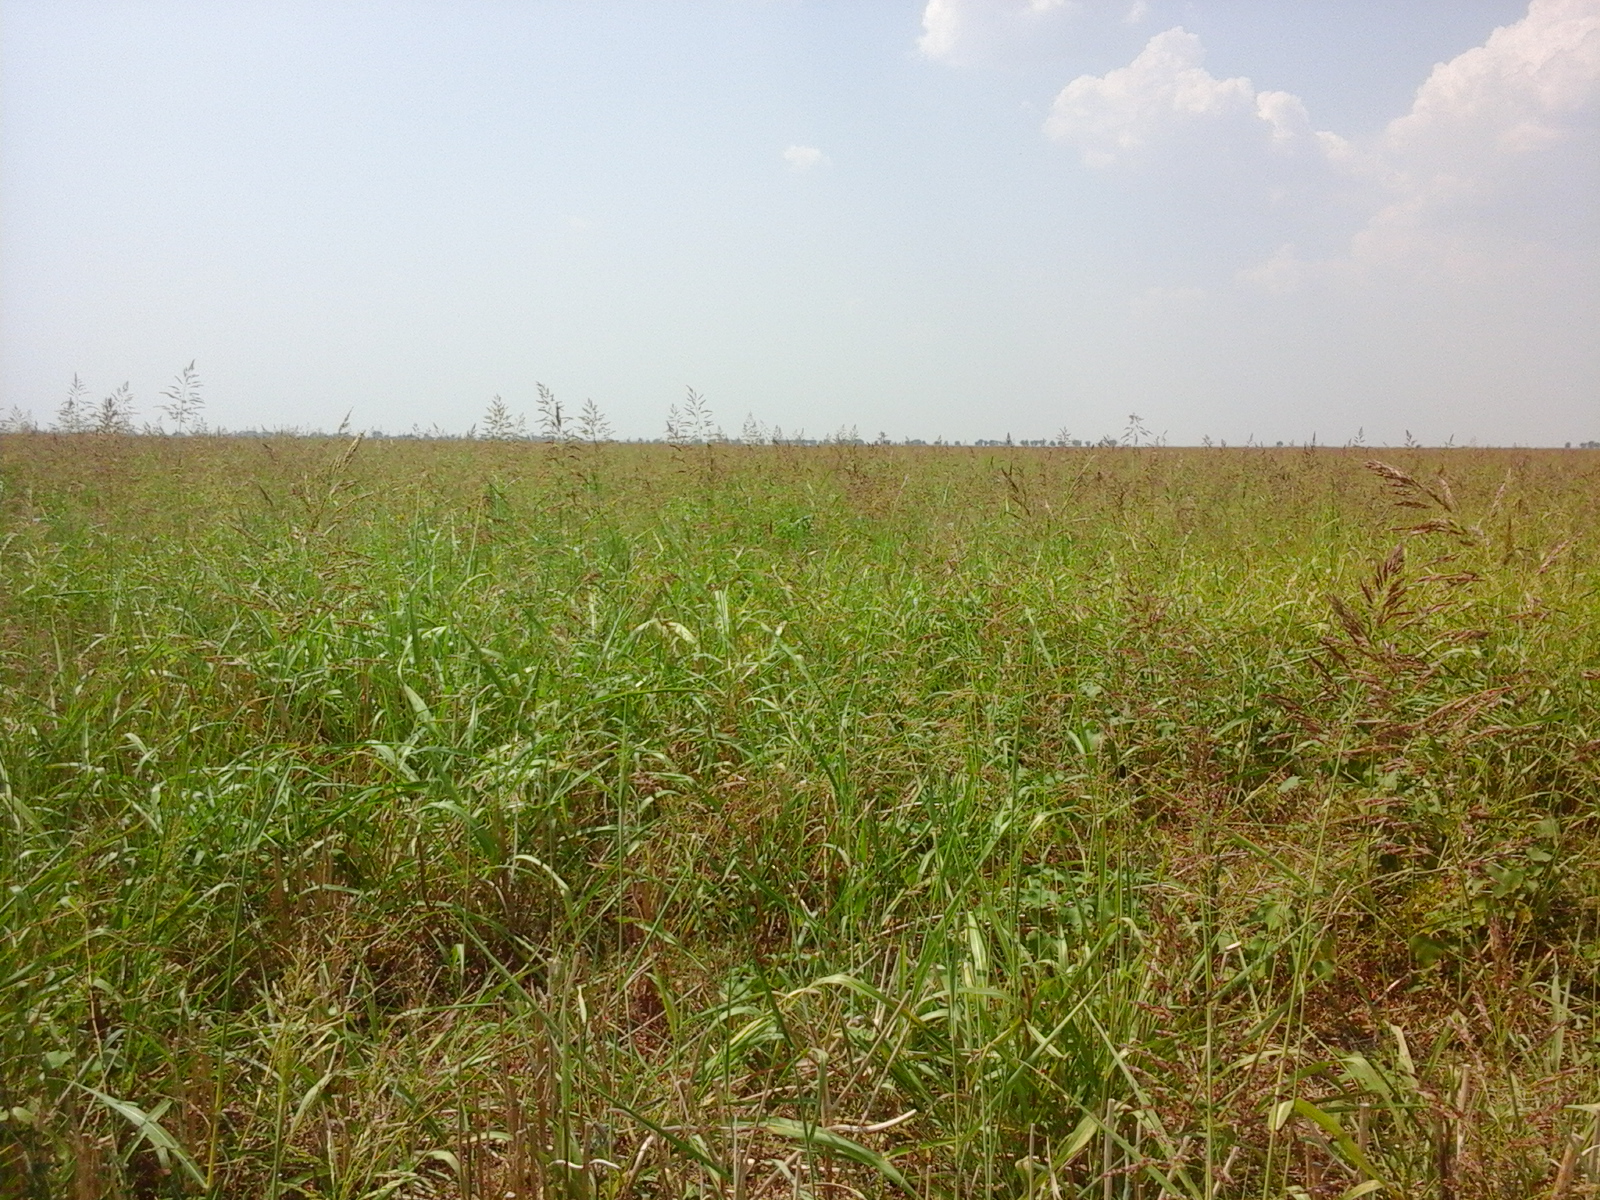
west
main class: Cropland
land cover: Rape and turnip rape
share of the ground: 10 - 25 %
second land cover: Spontaneously vegetated surfaces
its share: > 75 %
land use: Agriculture (excluding fallow land and kitchen gardens)
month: August
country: RO
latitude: 43.9415
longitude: 23.3394
